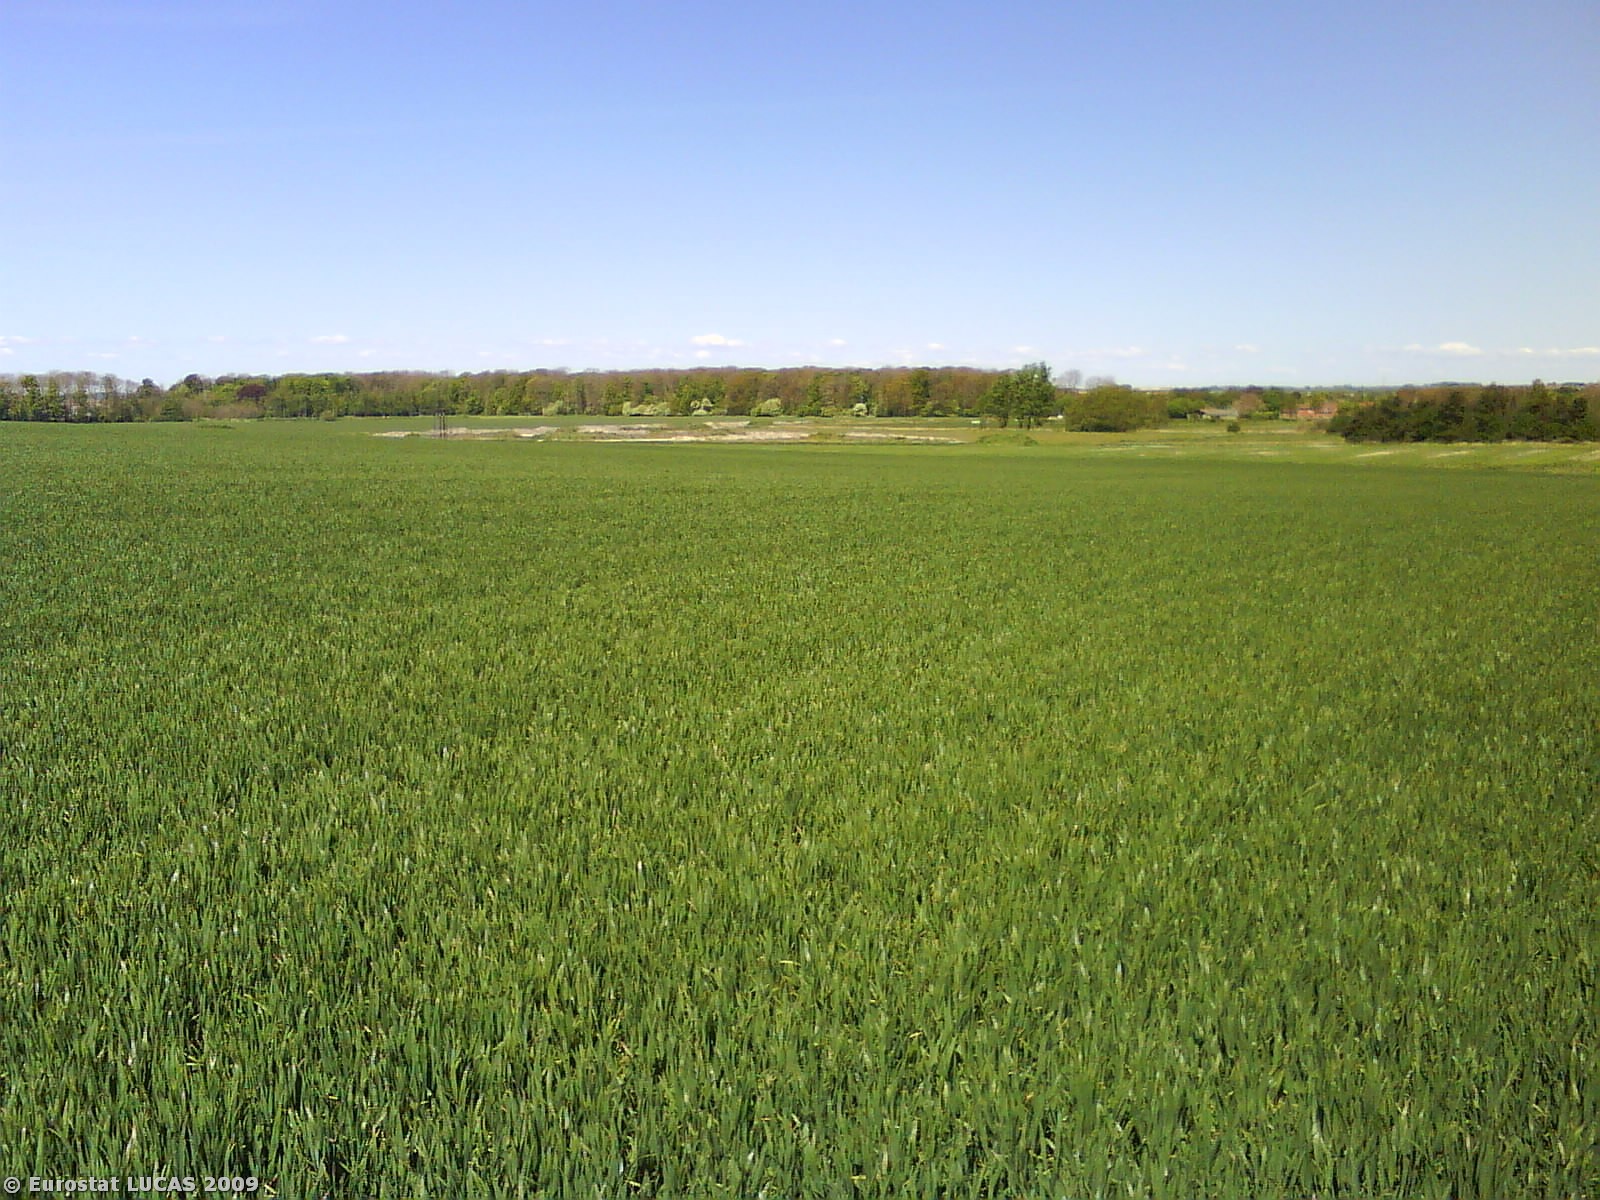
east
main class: Cropland
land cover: Common wheat
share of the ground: > 75 %
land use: Agriculture (excluding fallow land and kitchen gardens)
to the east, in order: Common wheat; Grass margins; Broadleaved woodland; Grass margins; Fences; Shrubland without tree cover
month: May
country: DK
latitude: 56.3824
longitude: 10.8896
